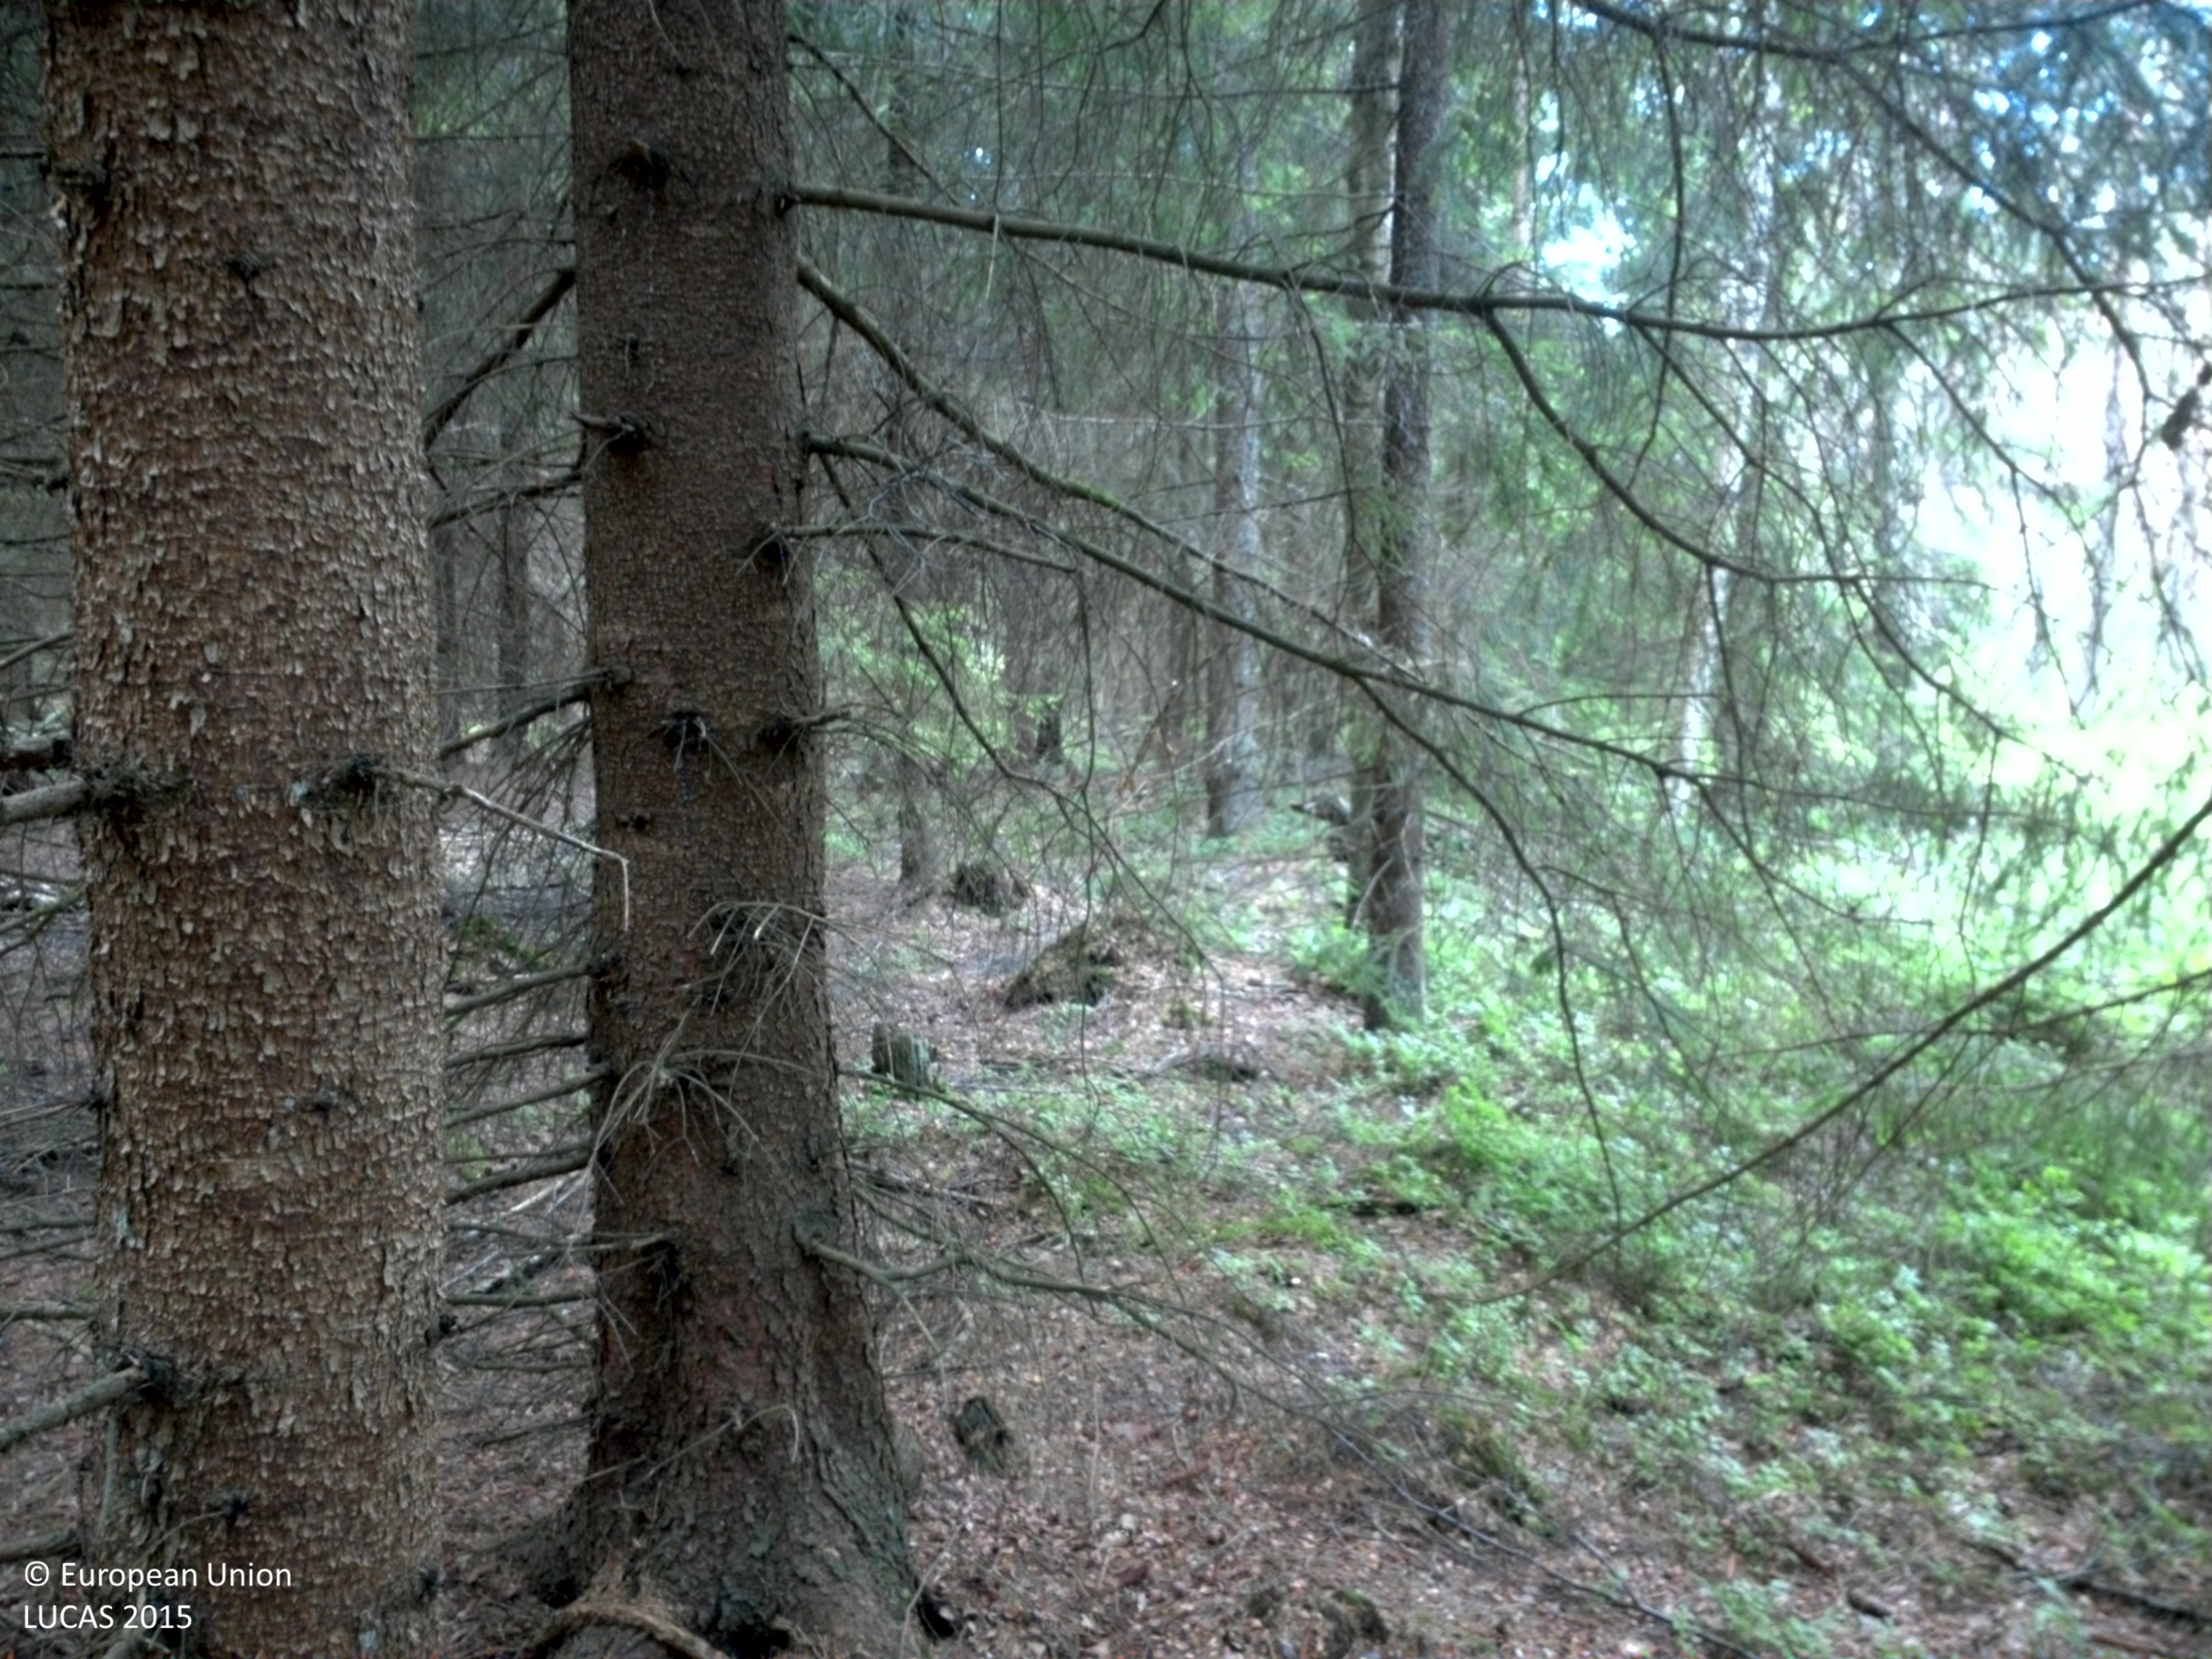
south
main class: Woodland
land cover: Spruce dominated coniferous woodland
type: boreal forest
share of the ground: 50 - 75 %
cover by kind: coniferous forest trees 70 %, herbaceous plants 10 %, consolidated bare surface 10 %, broadleaved forest trees 5 %, lichens and mosses 5 %
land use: Forestry
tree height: > 5 m
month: June
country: SE
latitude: 58.5629
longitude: 15.3743
